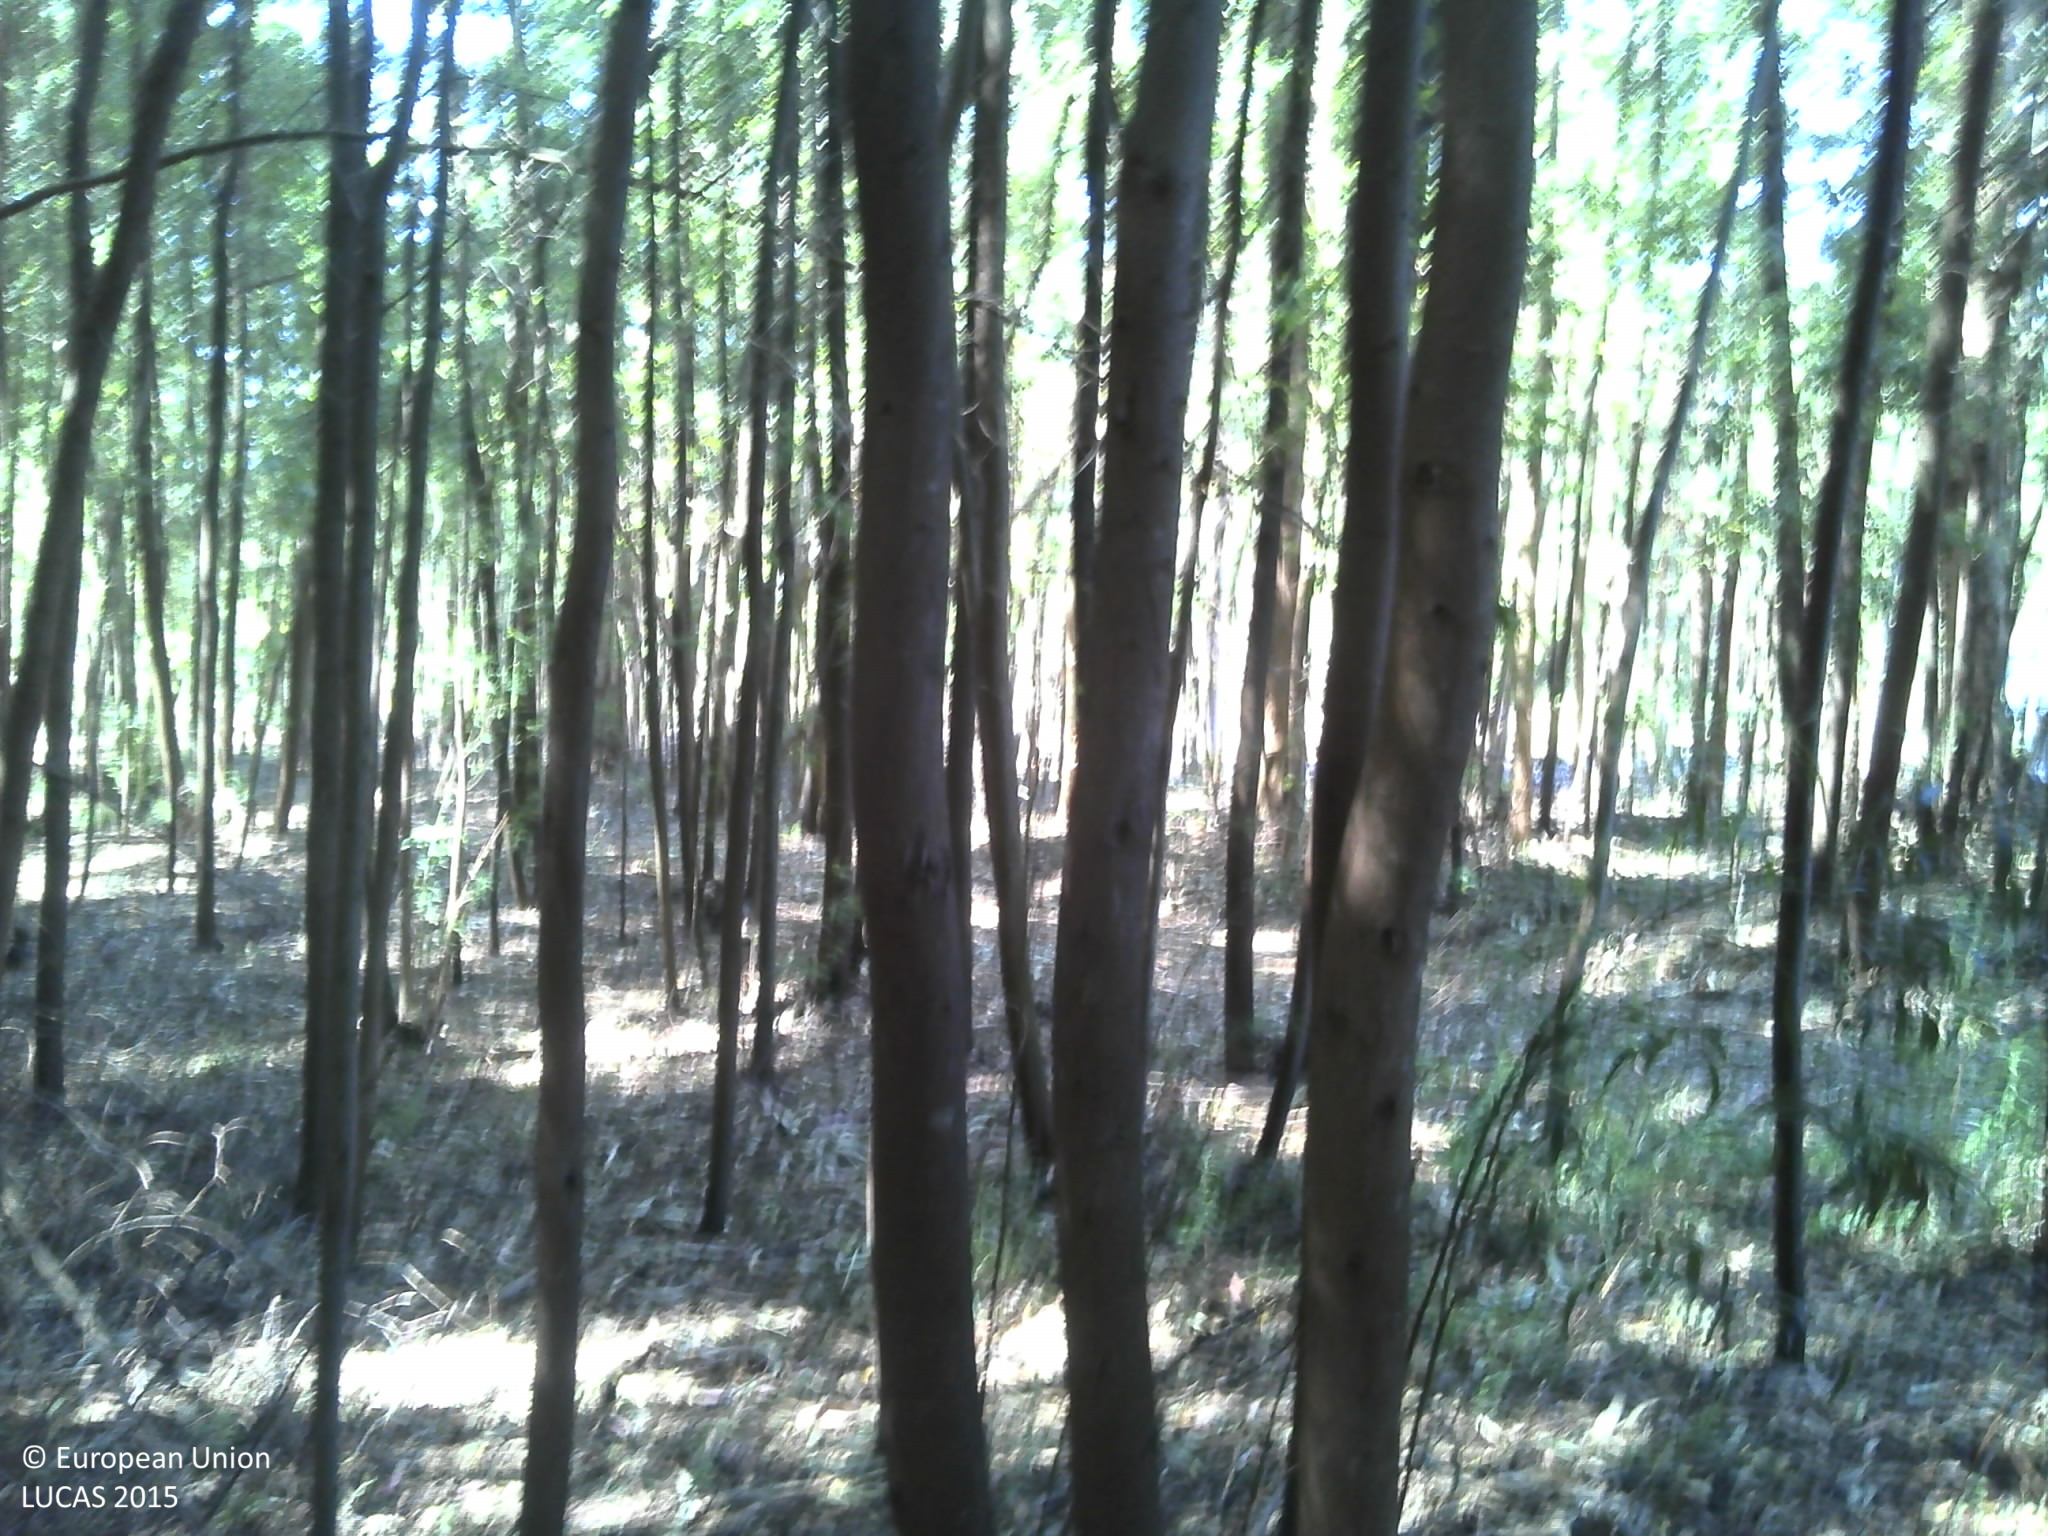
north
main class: Woodland
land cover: Broadleaved woodland
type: exotic forest
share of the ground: 50 - 75 %
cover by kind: broadleaved forest trees 75 %, shrubs 10 %, unconsolidated bare surface 10 %, herbaceous plants 5 %
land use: Forestry
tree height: > 5 m
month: May
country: PT
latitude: 40.4604
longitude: -8.7415
